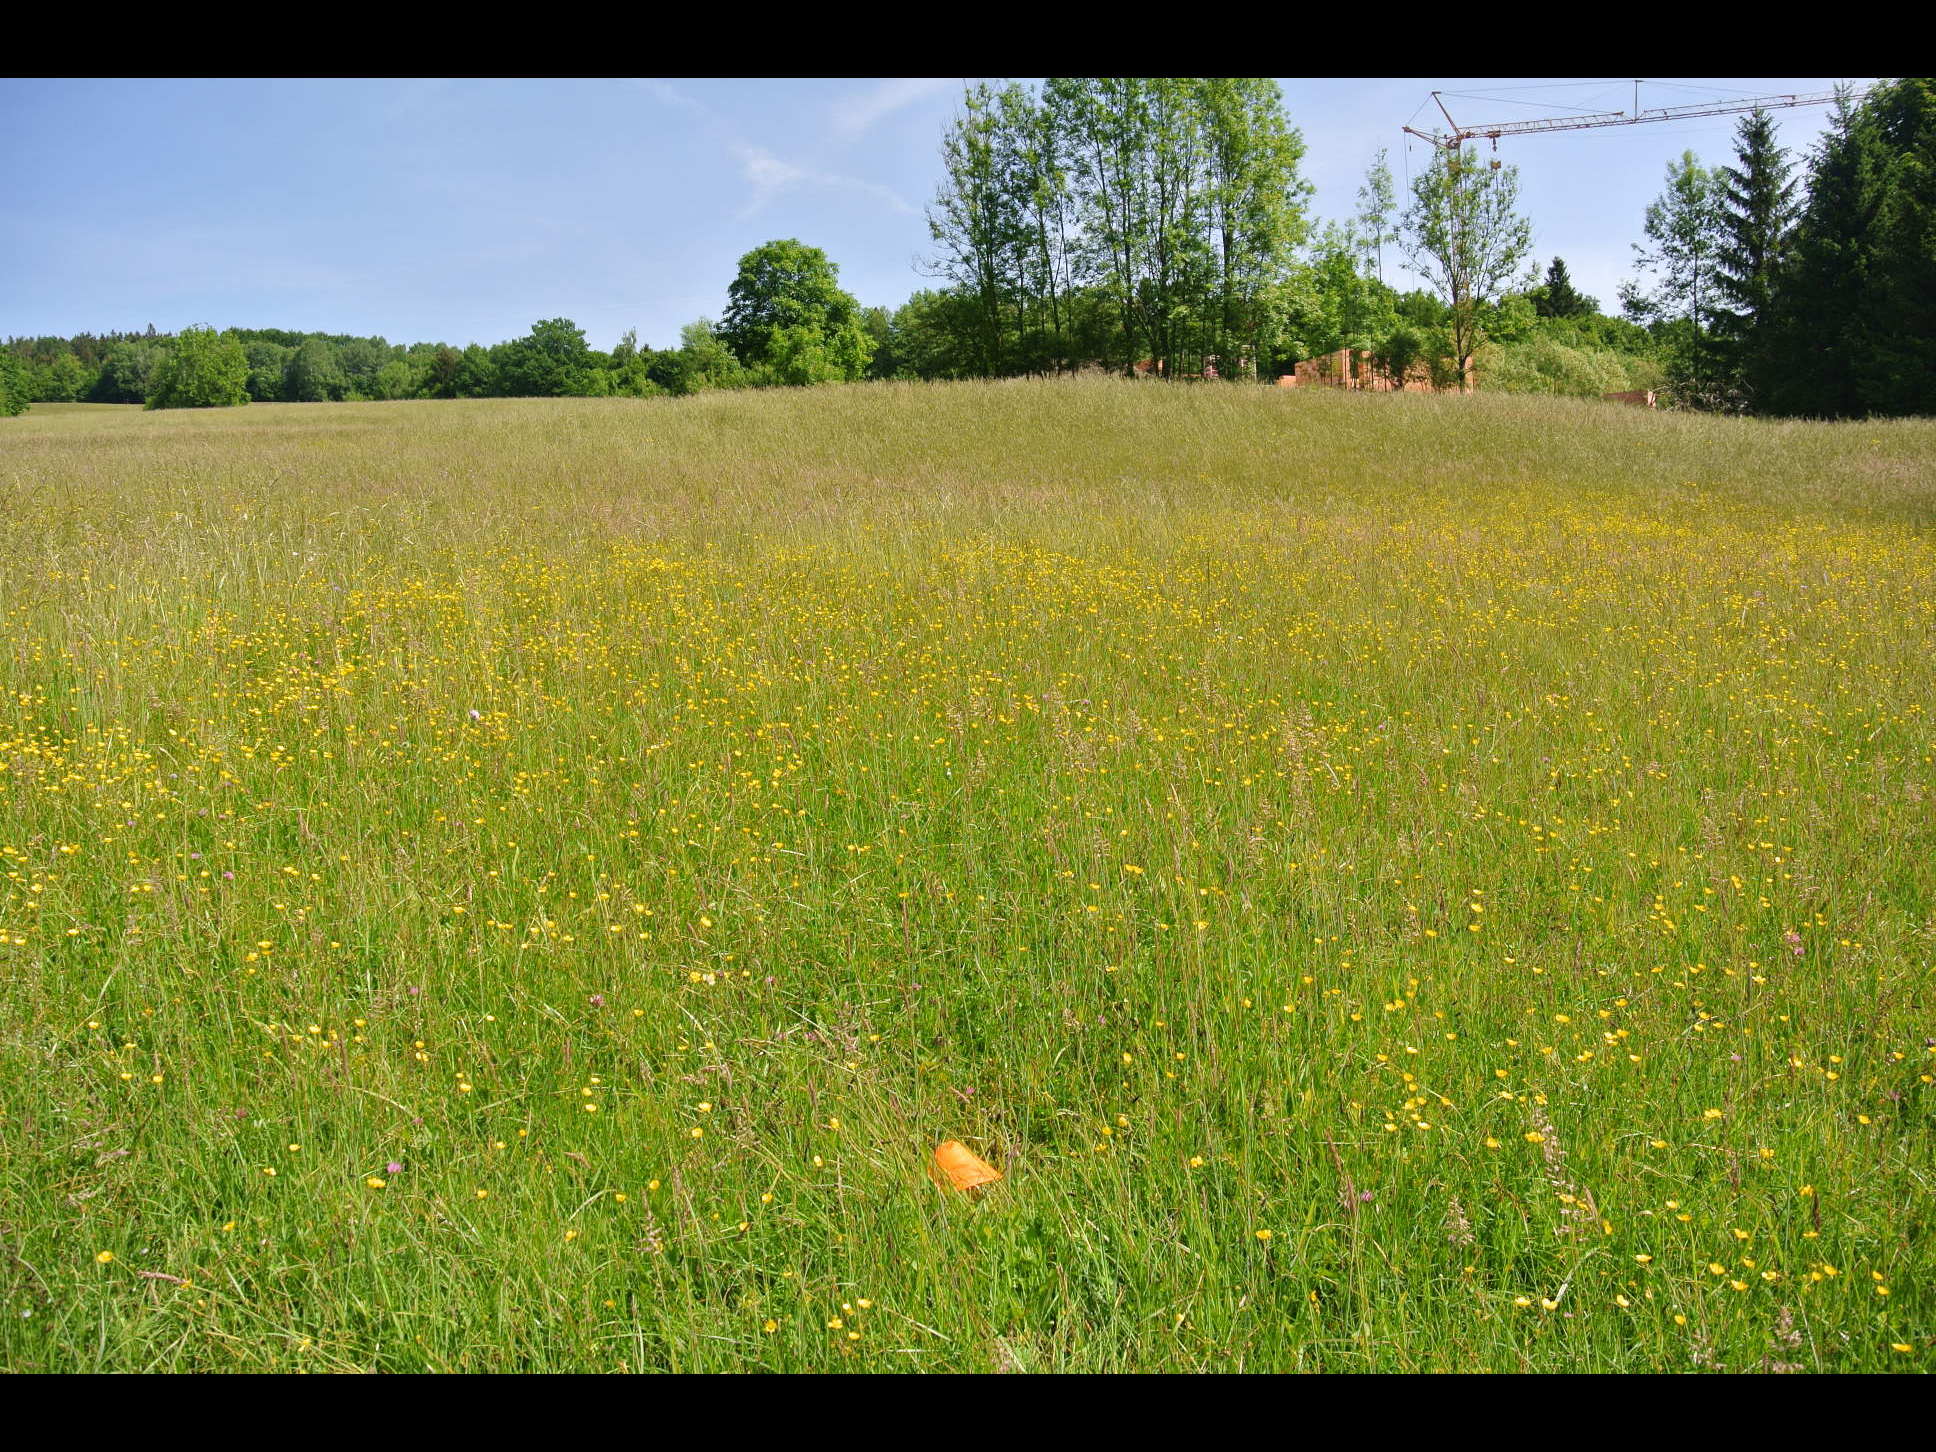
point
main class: Grassland
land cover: Grassland without tree/shrub cover
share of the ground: > 75 %
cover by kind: herbaceous plants 100 %
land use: Agriculture (excluding fallow land and kitchen gardens)
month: May
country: AT
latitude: 48.0357
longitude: 15.7833
